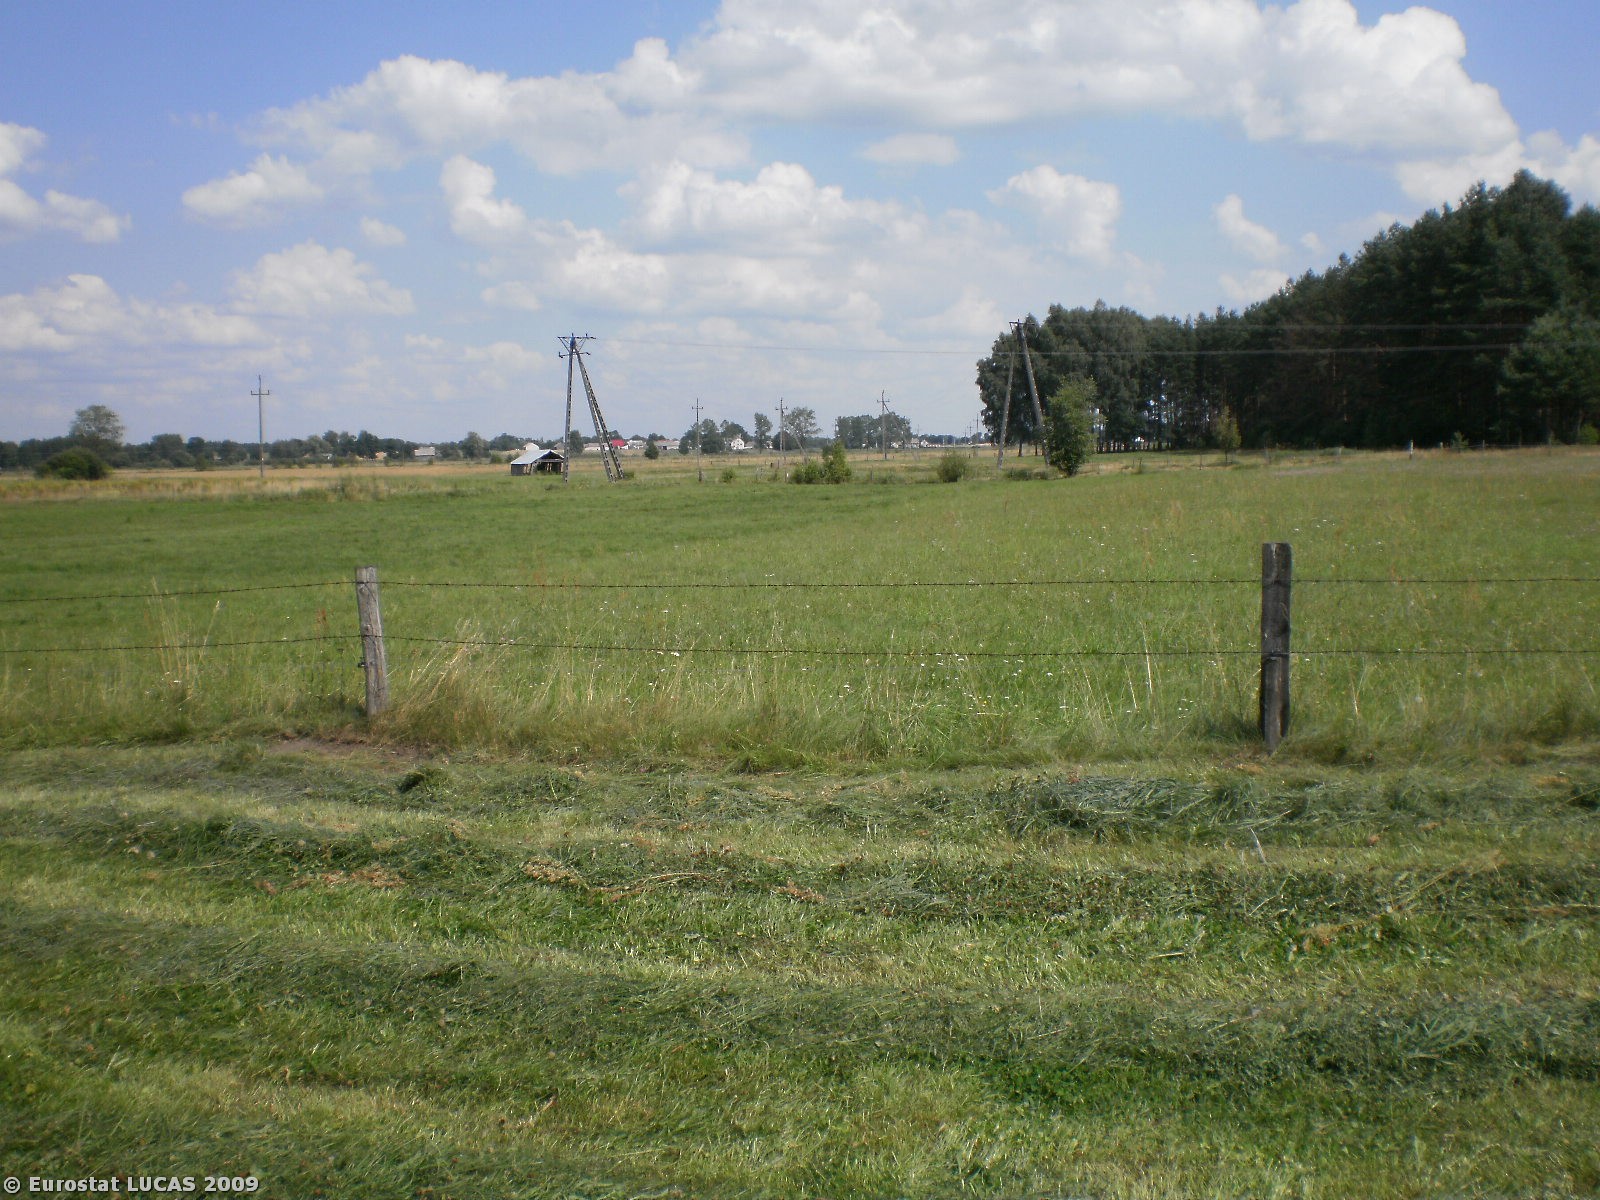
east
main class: Grassland
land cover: Grassland without tree/shrub cover
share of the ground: > 75 %
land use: Agriculture (excluding fallow land and kitchen gardens)
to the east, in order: Grassland without tree/shrub cover; Fences; Grassland without tree/shrub cover; Fences; Grassland without tree/shrub cover; Fences; Tracks; Grassland without tree/shrub cover; Electric lines; Grassland without tree/shrub cover
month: July
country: PL
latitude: 53.3967
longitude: 21.3117
